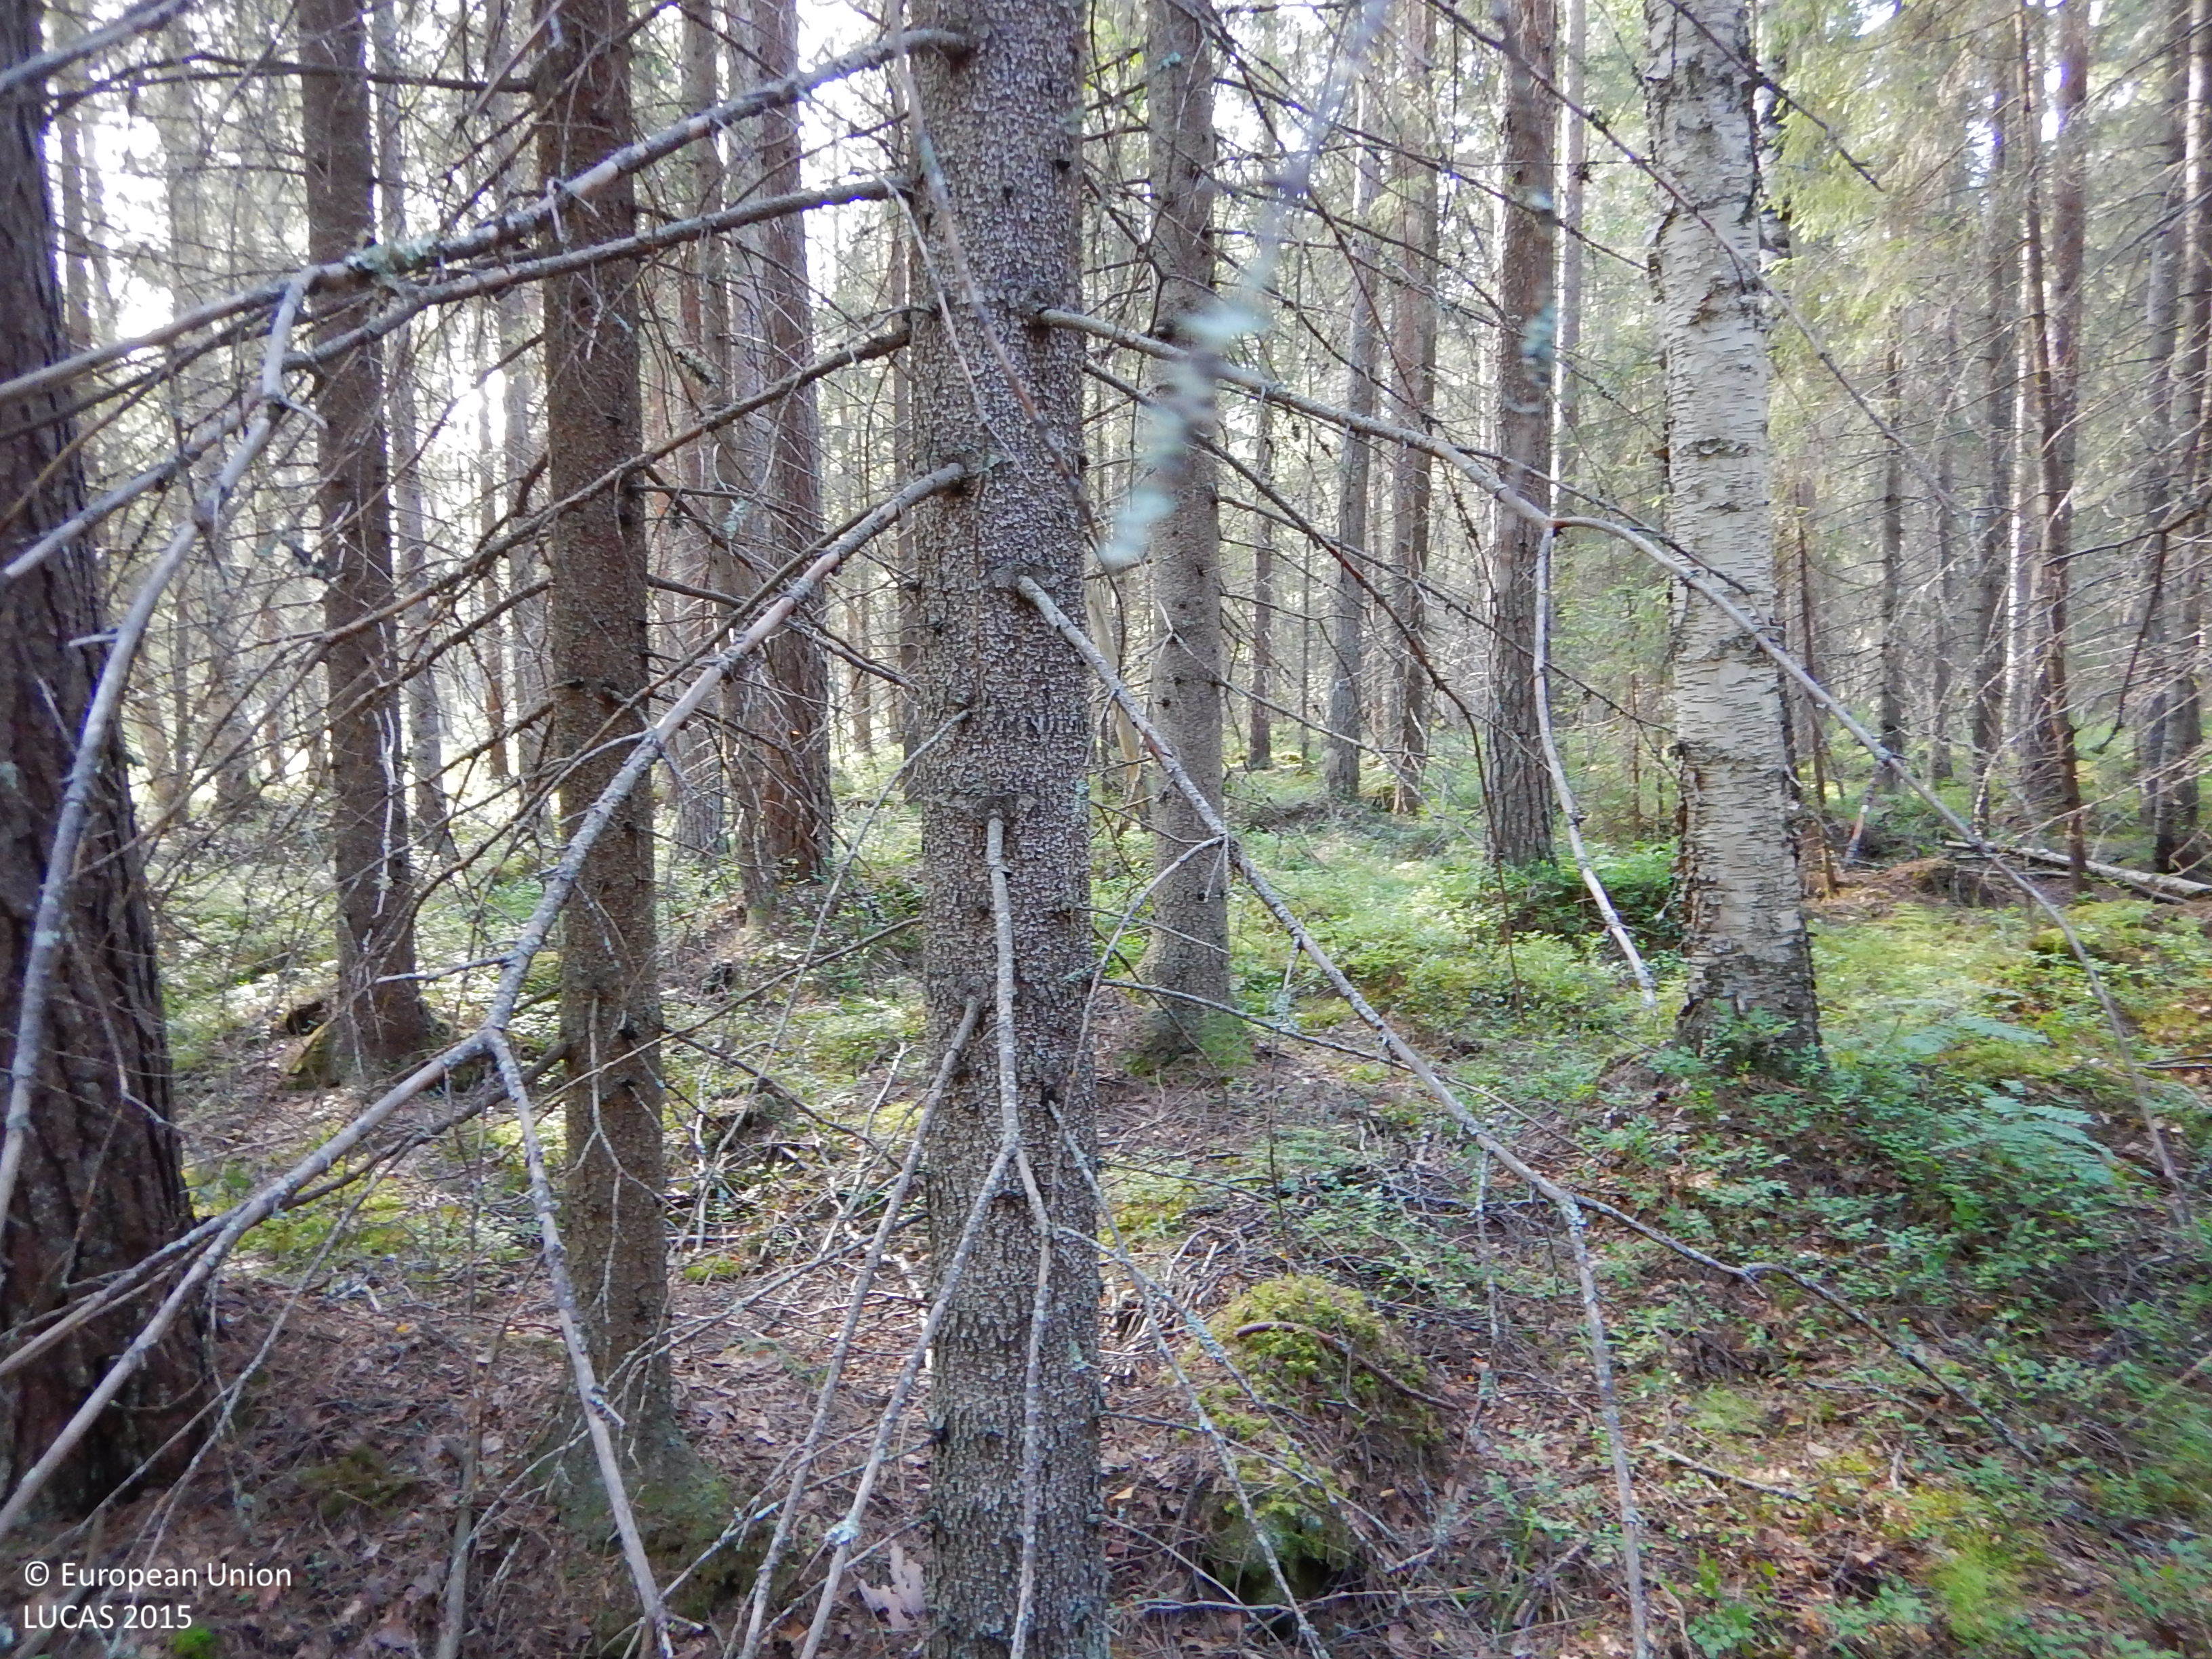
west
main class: Woodland
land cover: Spruce dominated coniferous woodland
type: boreal forest
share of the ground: 50 - 75 %
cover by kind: coniferous forest trees 55 %, lichens and mosses 20 %, broadleaved forest trees 10 %, shrubs 10 %, herbaceous plants 5 %
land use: Forestry
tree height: > 5 m
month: July
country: SE
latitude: 64.8015
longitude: 20.9872
